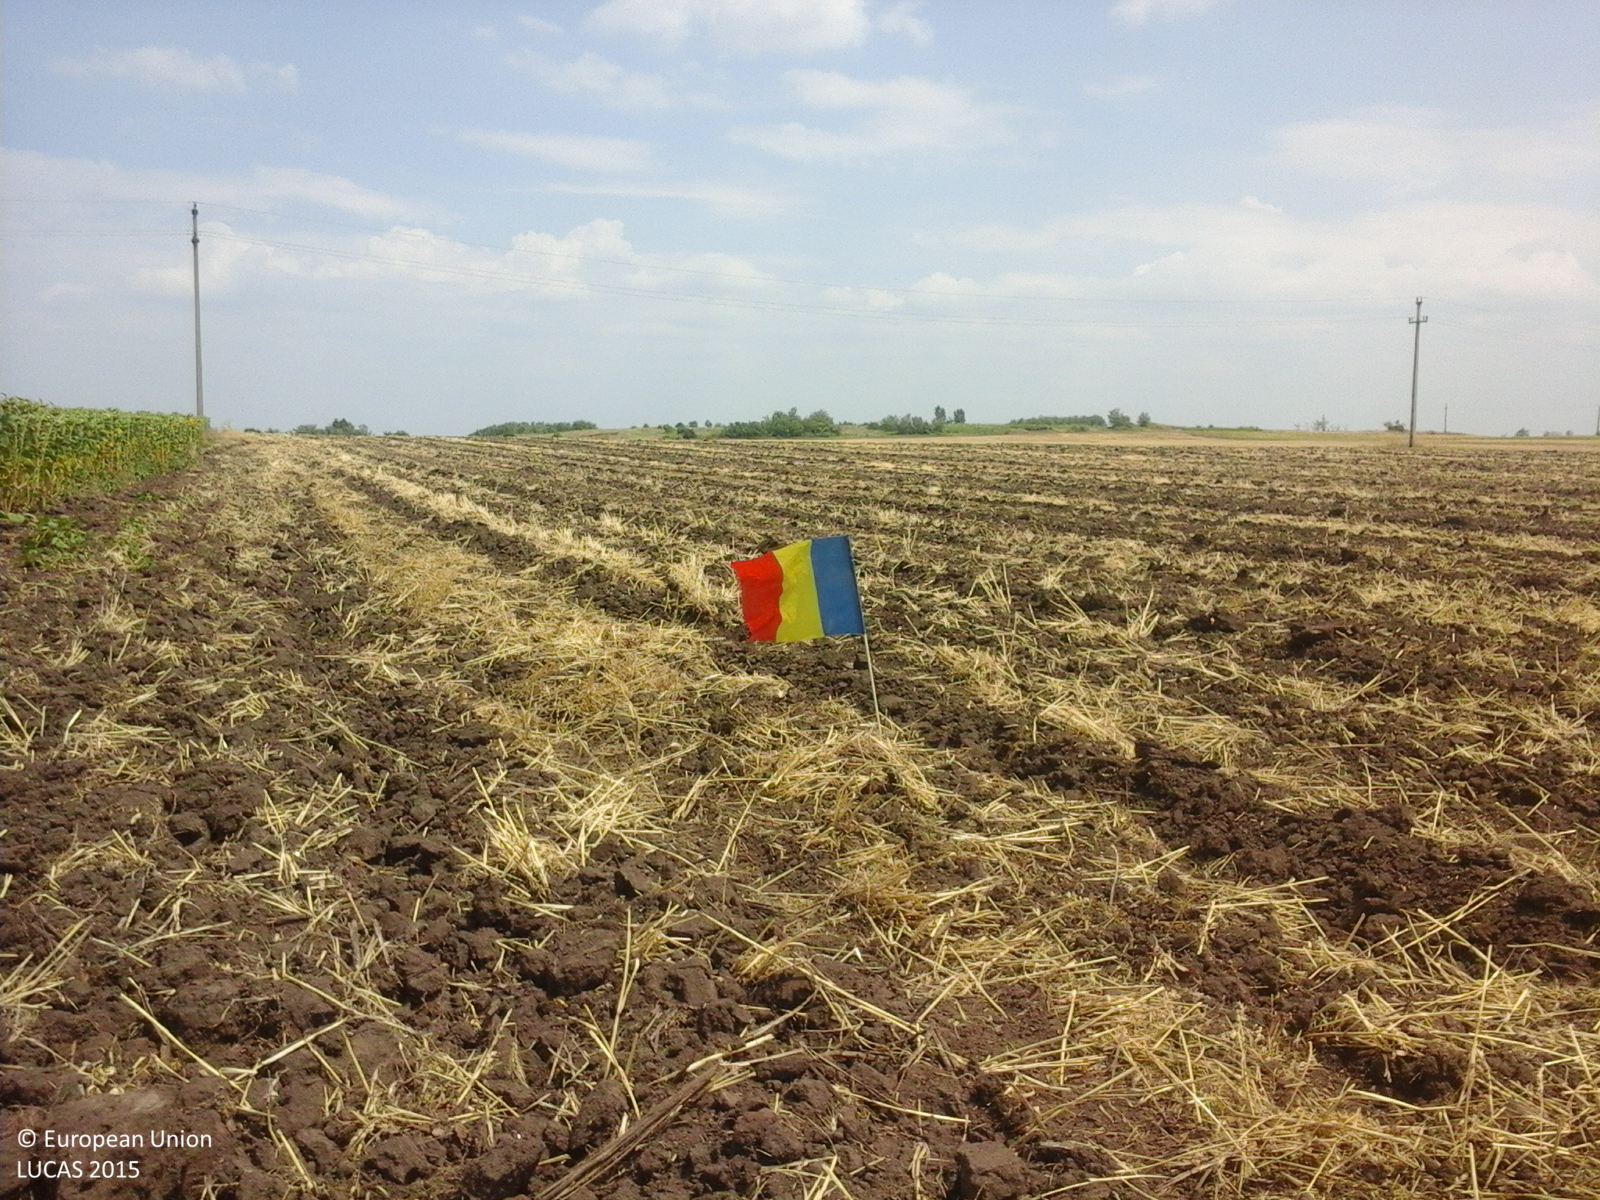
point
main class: Cropland
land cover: Common wheat
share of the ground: 10 - 25 %
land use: Agriculture (excluding fallow land and kitchen gardens)
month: July
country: RO
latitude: 46.0614
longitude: 28.0004
